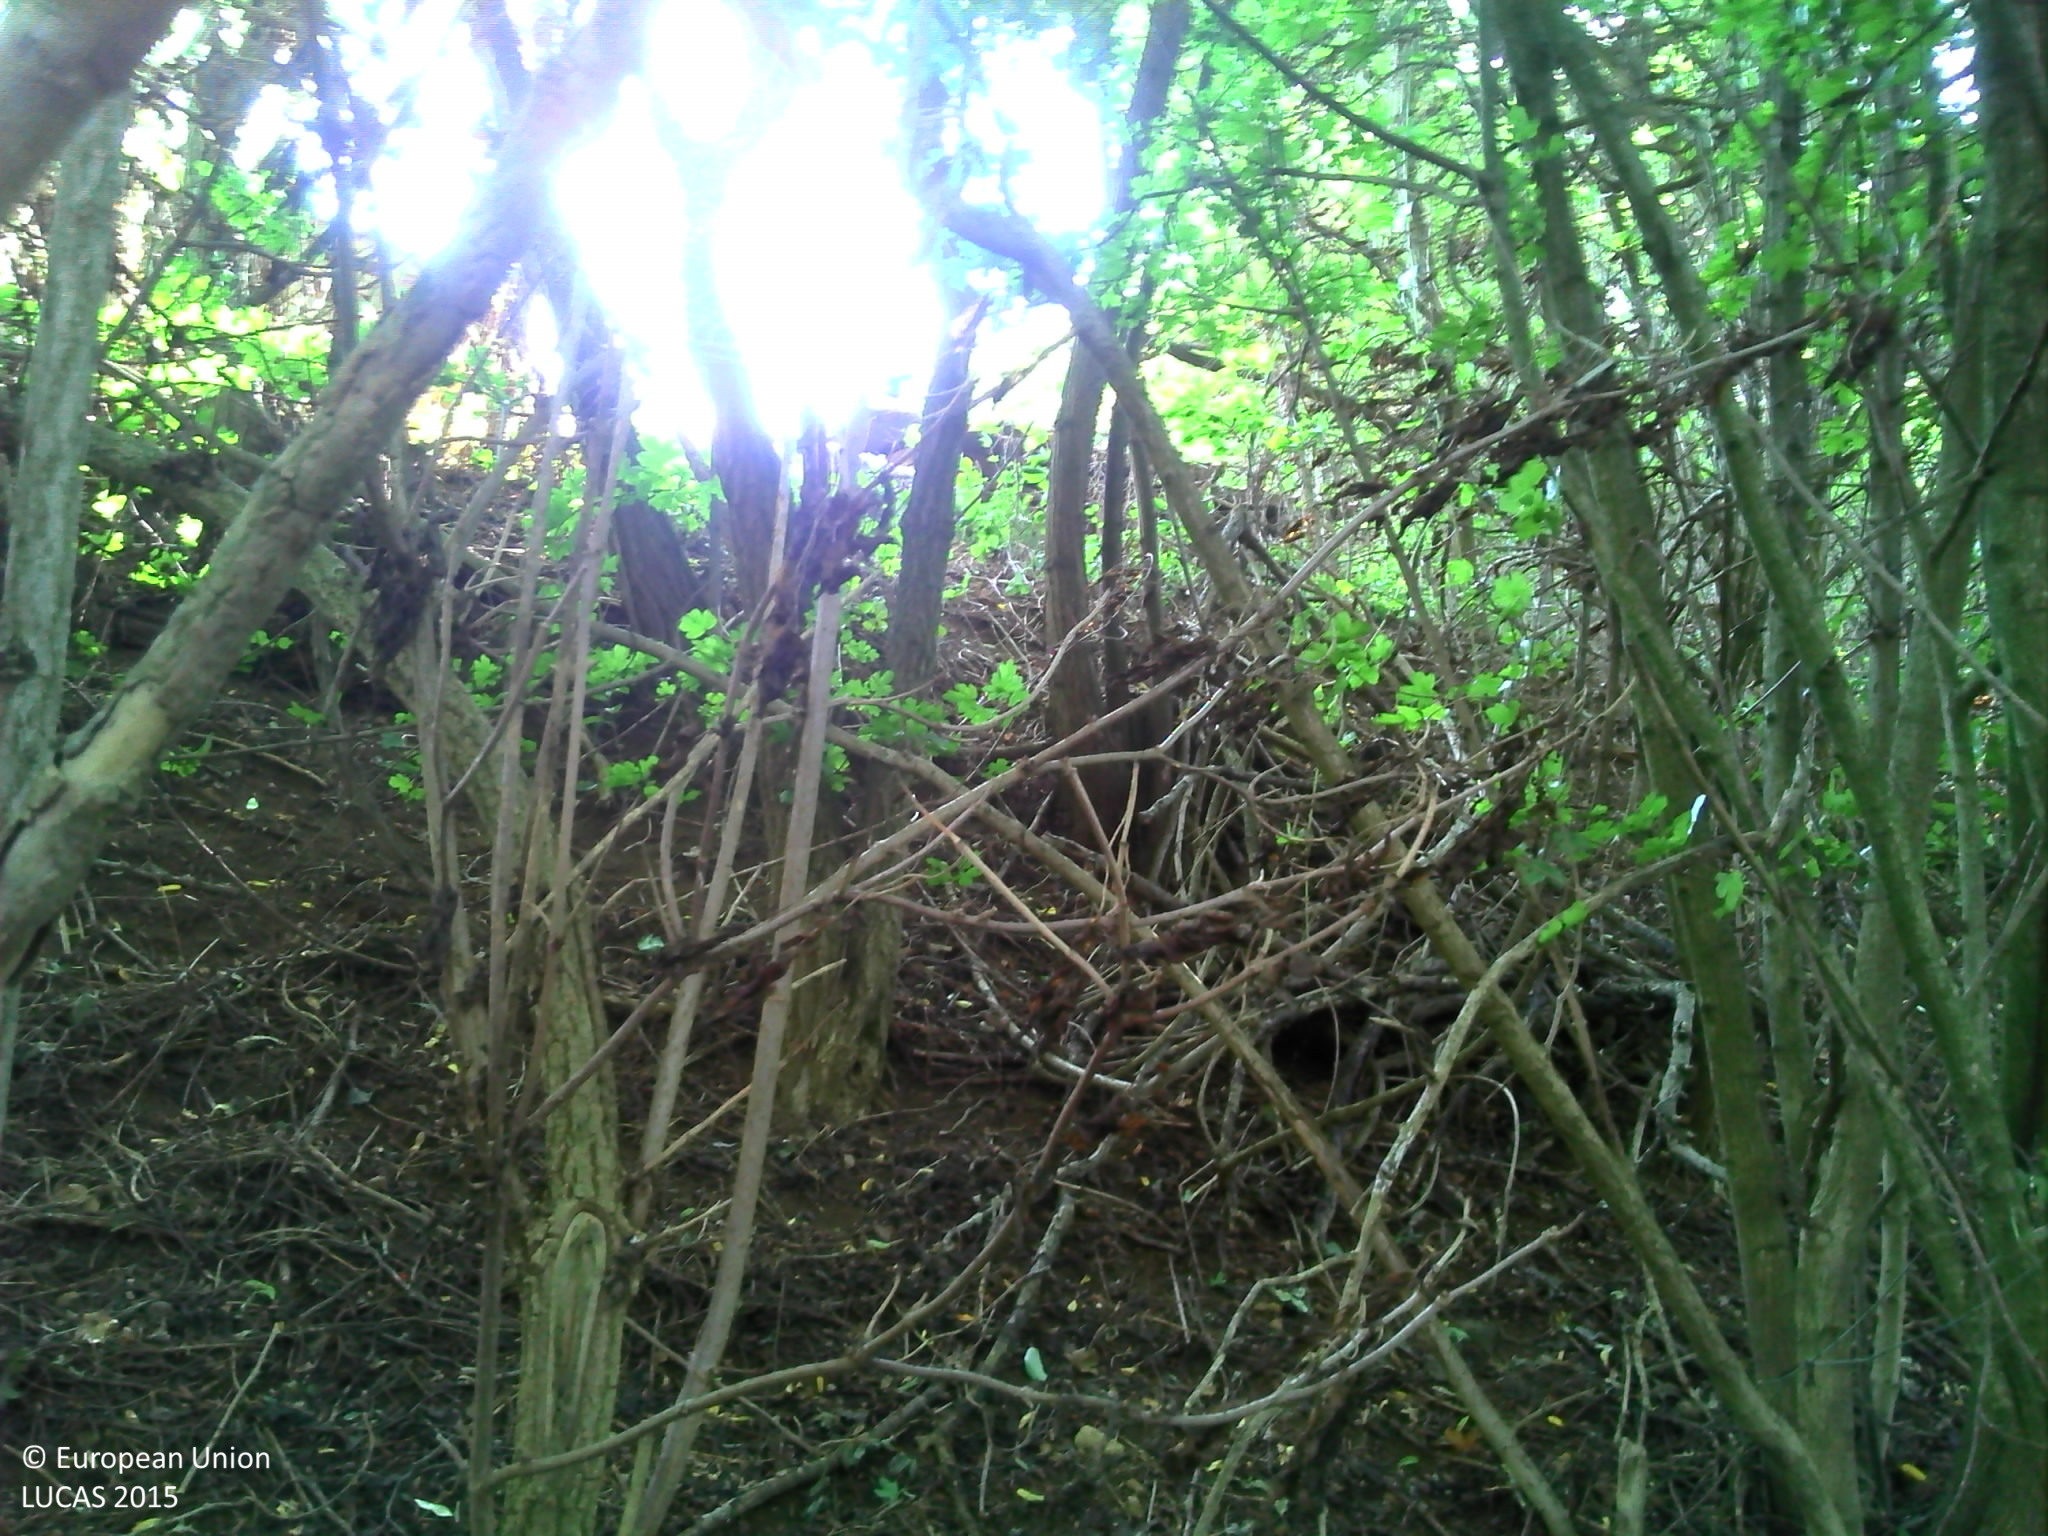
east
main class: Woodland
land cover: Broadleaved woodland
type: mesophytic deciduous forest
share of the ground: > 75 %
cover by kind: broadleaved forest trees 95 %, herbaceous plants 5 %
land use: Agriculture (excluding fallow land and kitchen gardens)
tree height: > 5 m
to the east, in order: Broadleaved woodland; Fences; Grass margins; Tracks; Grassland without tree/shrub cover; Vineyards; Grassland without tree/shrub cover; Common wheat; Grassland without tree/shrub cover; Tracks; Grass margins; Common wheat; Tracks; Grass margins; Maize
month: August
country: FR
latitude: 48.7918
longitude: 7.6186
